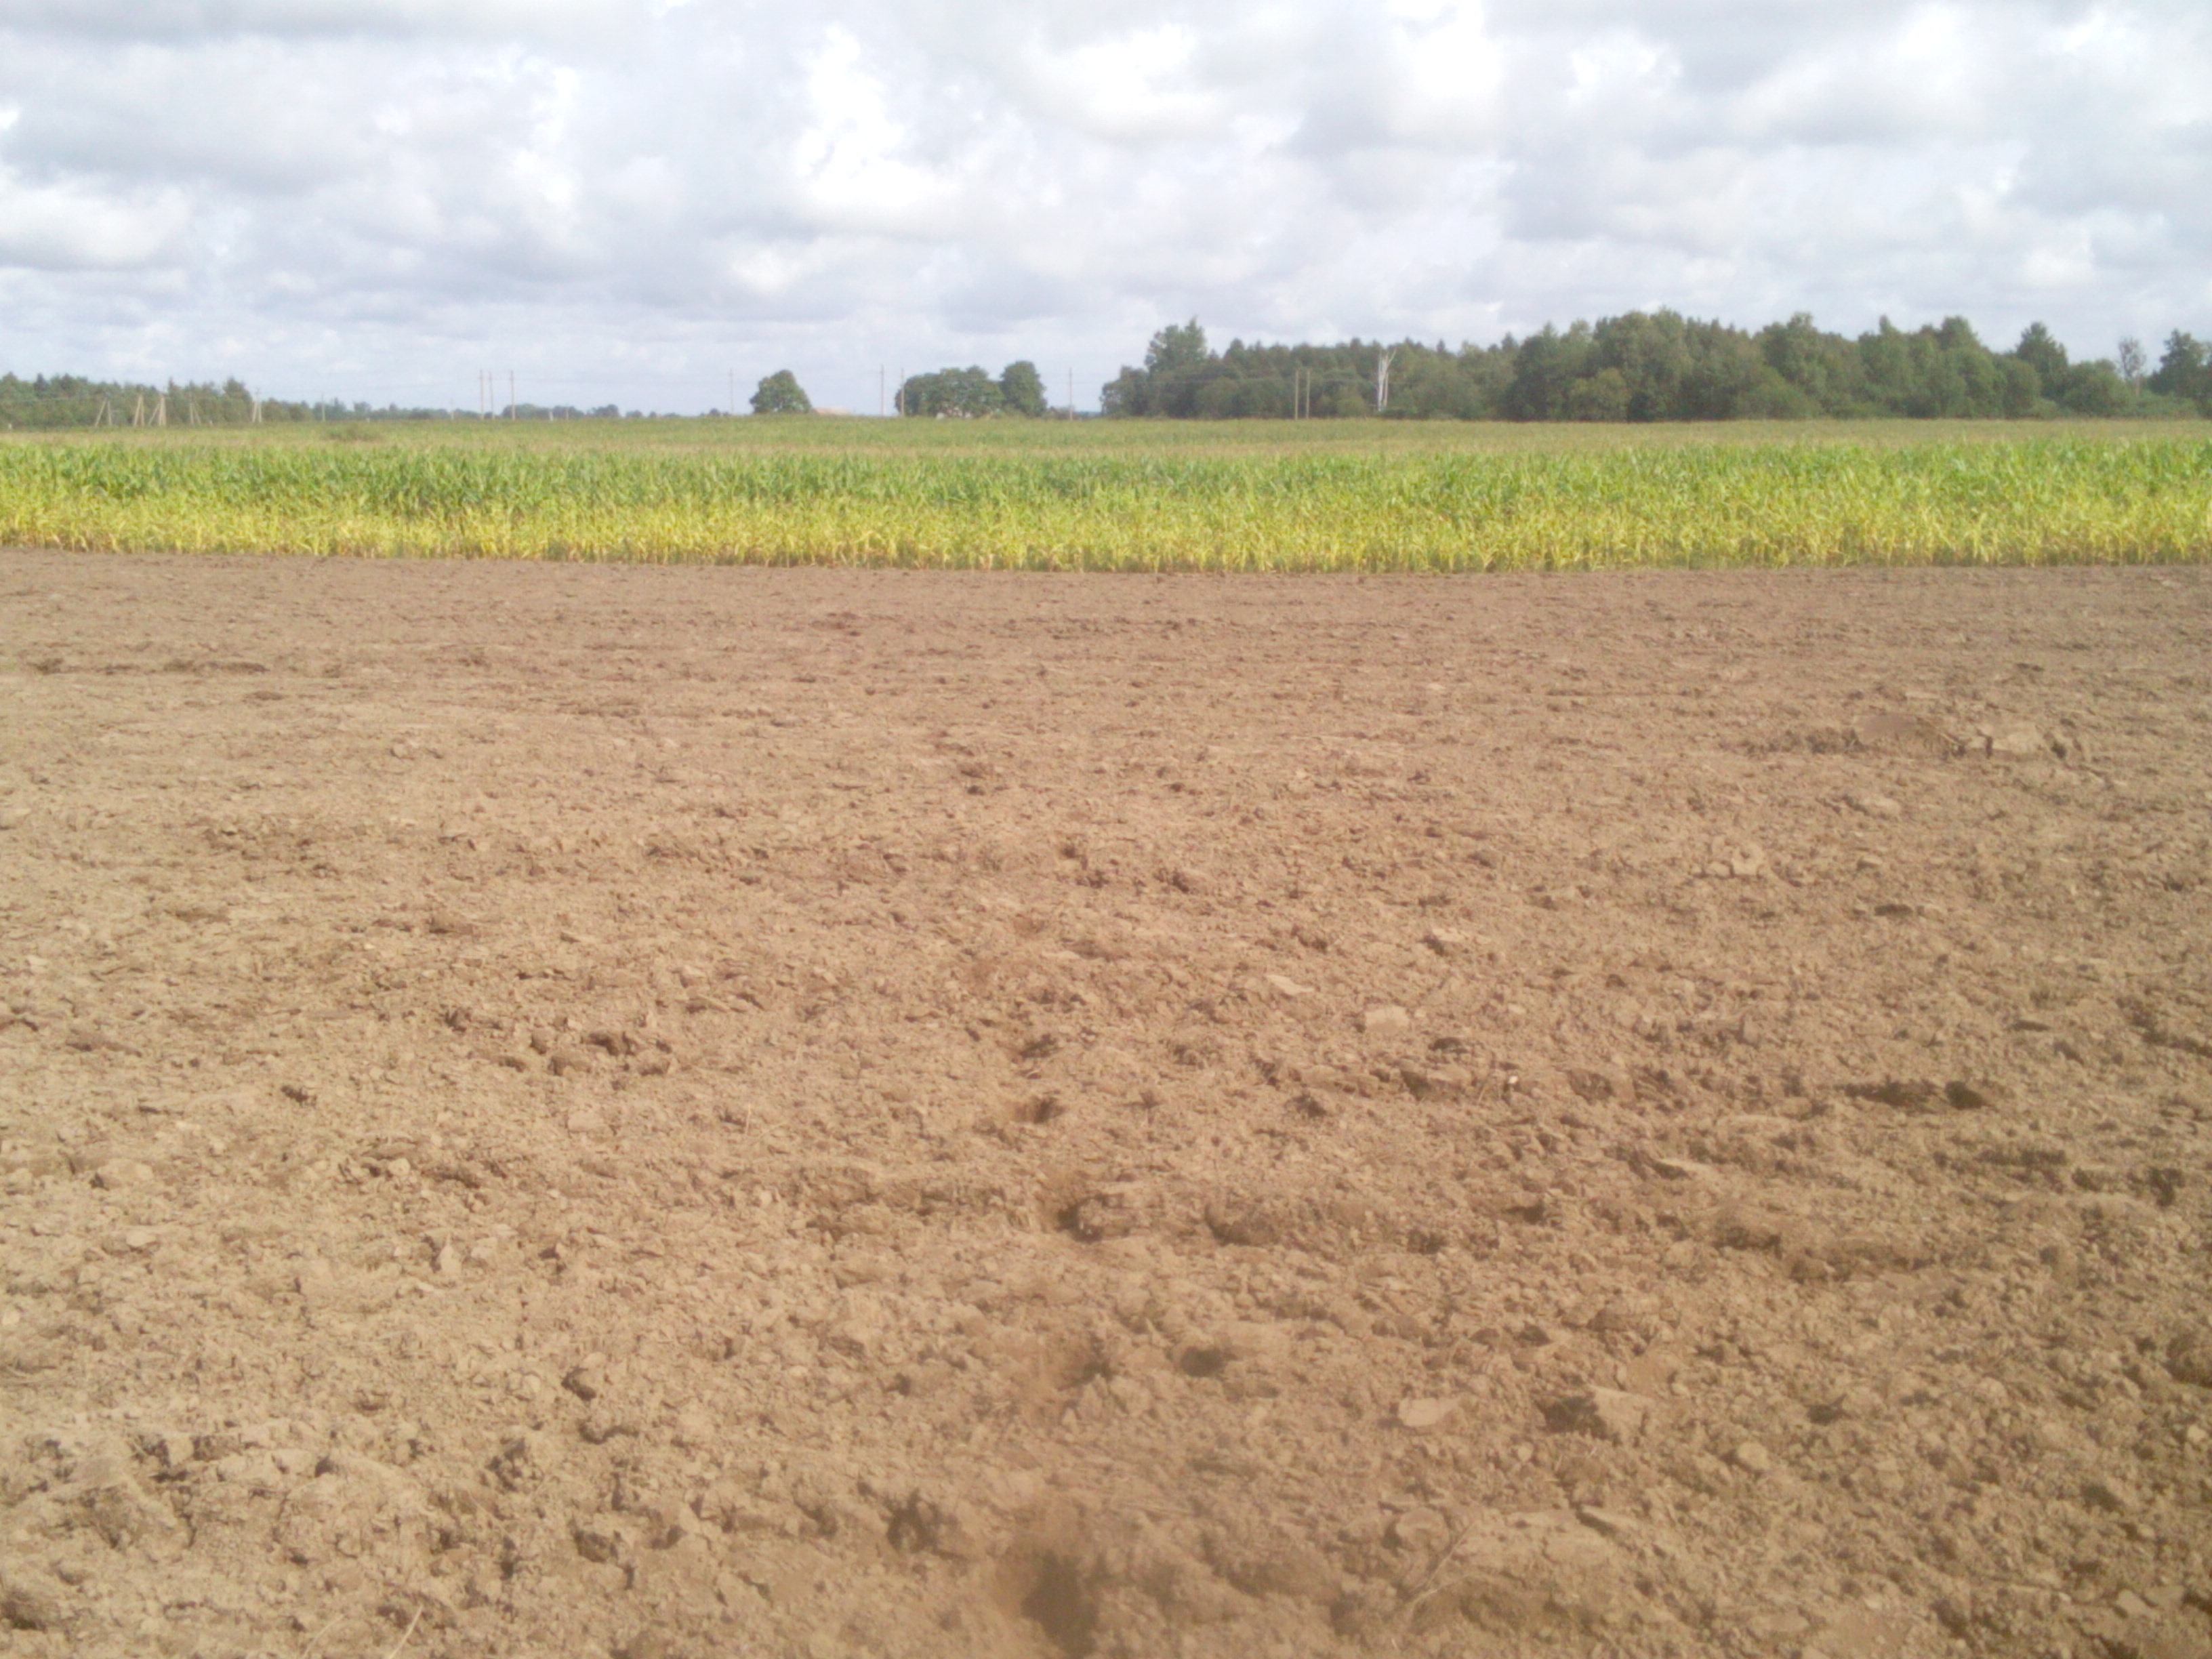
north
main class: Cropland
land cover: Common wheat
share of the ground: < 10 %
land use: Agriculture (excluding fallow land and kitchen gardens)
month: September
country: LT
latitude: 55.9027
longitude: 22.4871
